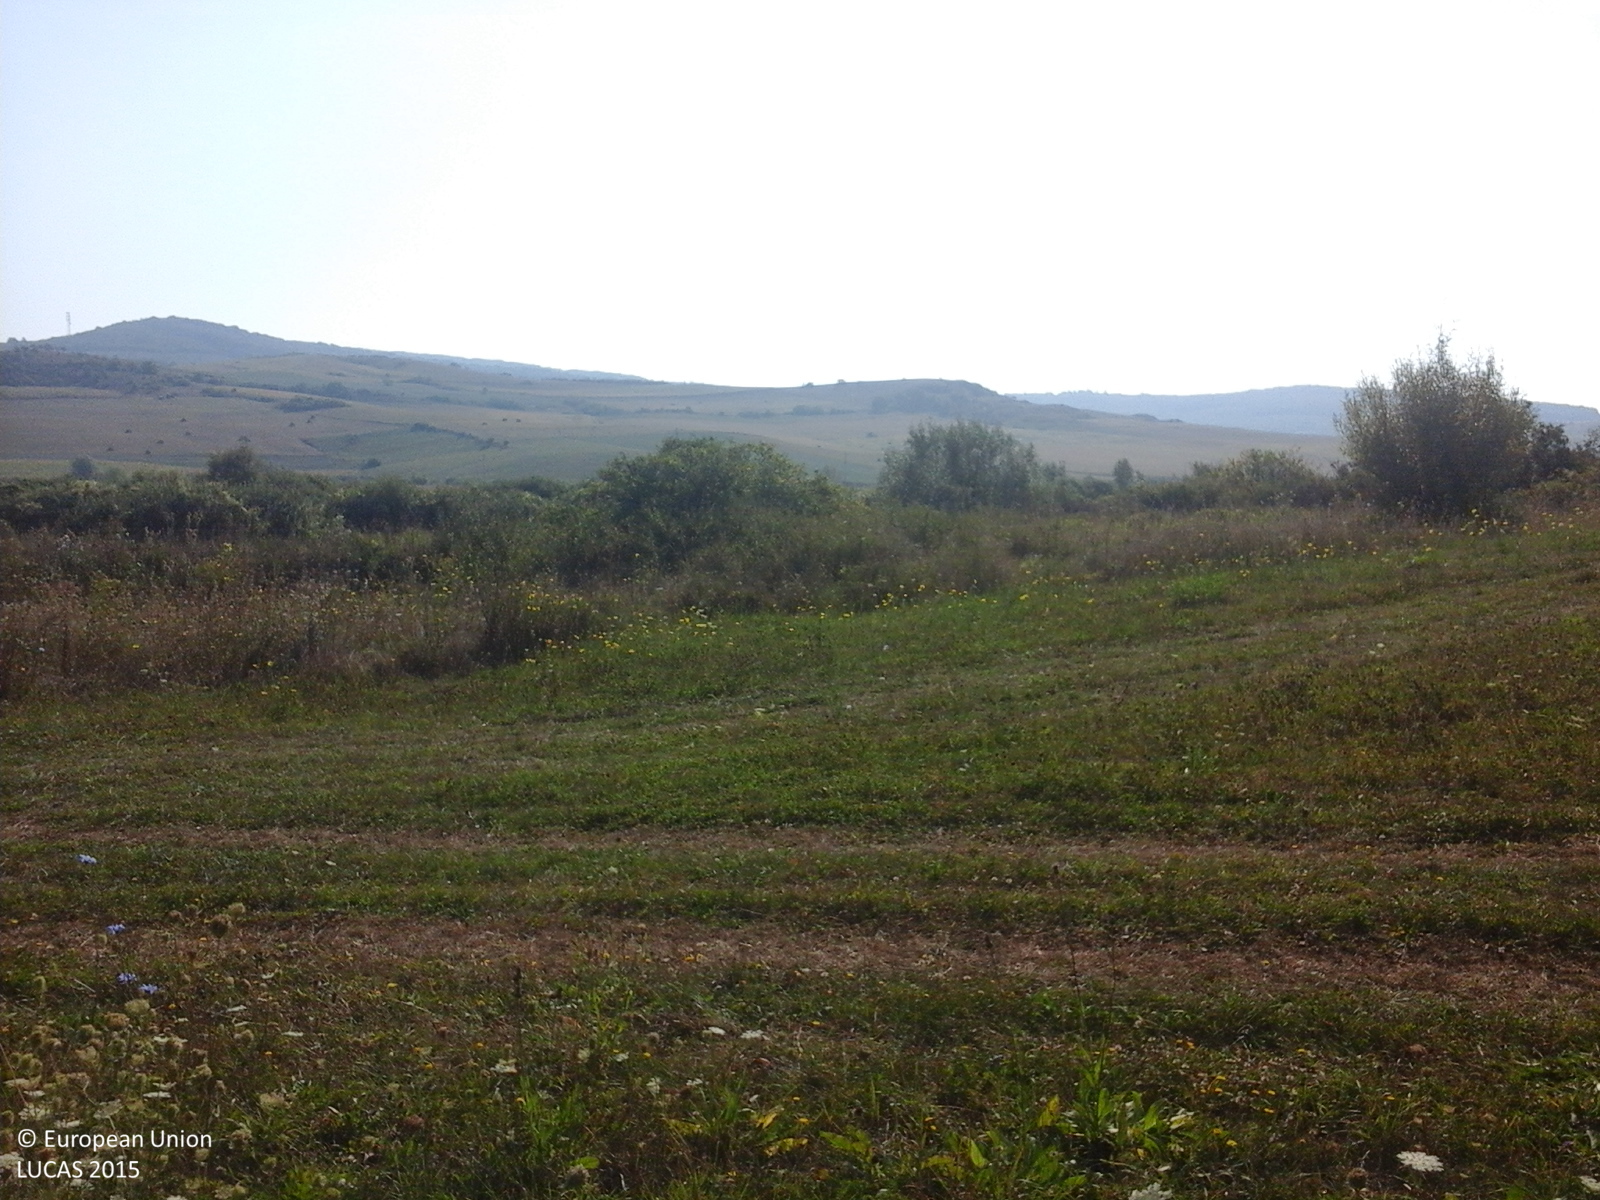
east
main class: Grassland
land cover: Spontaneously vegetated surfaces
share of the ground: > 75 %
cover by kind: herbaceous plants 100 %
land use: Fallow land
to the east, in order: Spontaneously vegetated surfaces; Tracks; Spontaneously vegetated surfaces; Abandoned hedges; Railways; Abandoned hedges; Spontaneously vegetated surfaces; Abandoned hedges; Spontaneously vegetated surfaces; Tracks; Spontaneously vegetated surfaces; Abandoned hedges; Ditches and canals; Abandoned hedges; Spontaneously vegetated surfaces; Maize
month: September
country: RO
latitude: 46.8944
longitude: 24.4877
